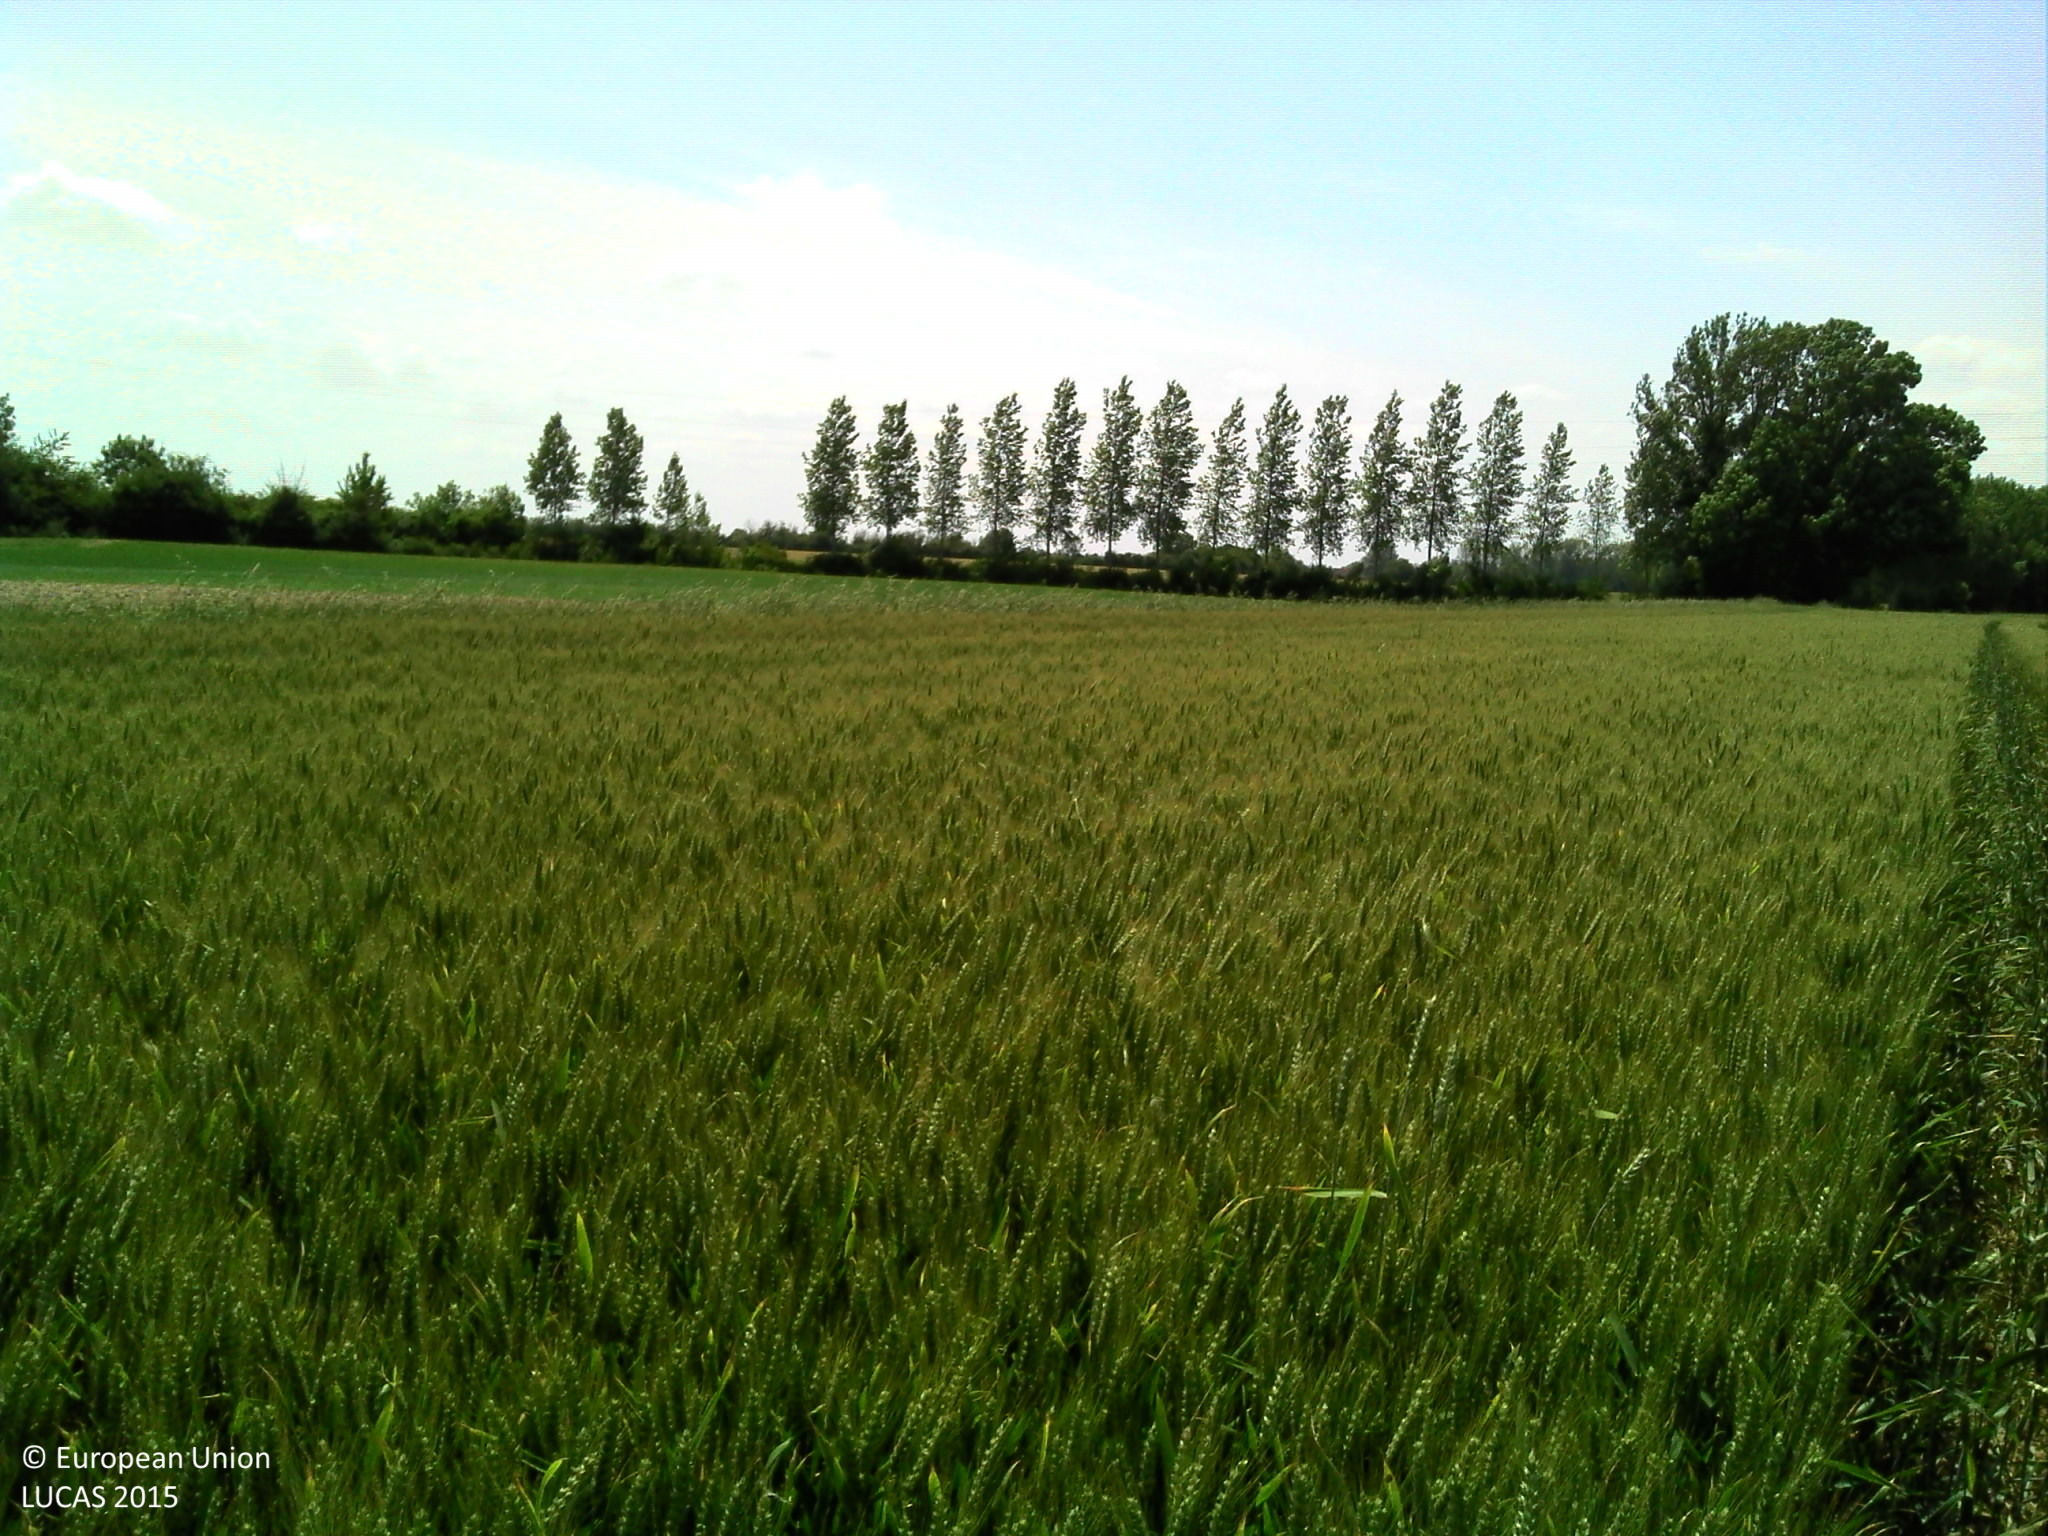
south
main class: Cropland
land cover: Common wheat
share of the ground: > 75 %
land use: Agriculture (excluding fallow land and kitchen gardens)
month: June
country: FR
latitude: 46.9497
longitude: 2.6761
